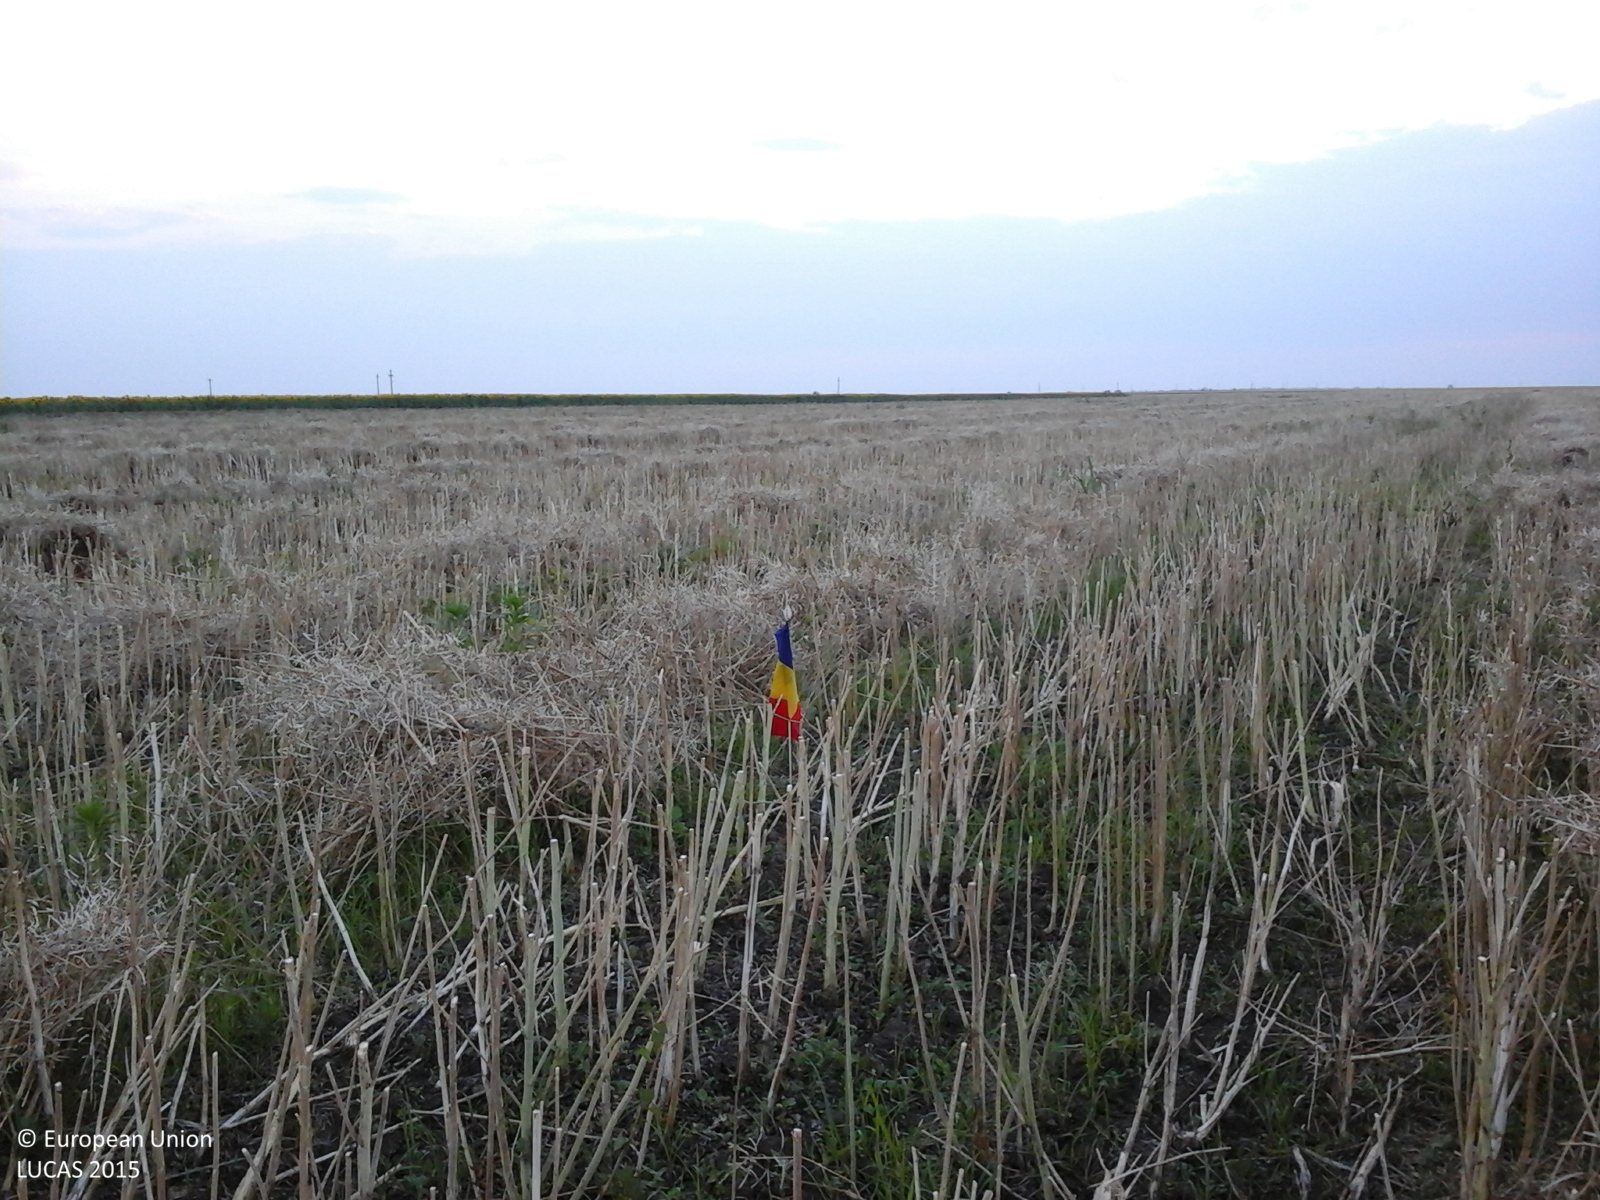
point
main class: Cropland
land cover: Rape and turnip rape
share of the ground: < 10 %
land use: Agriculture (excluding fallow land and kitchen gardens)
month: July
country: RO
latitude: 43.7659
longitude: 25.2464
